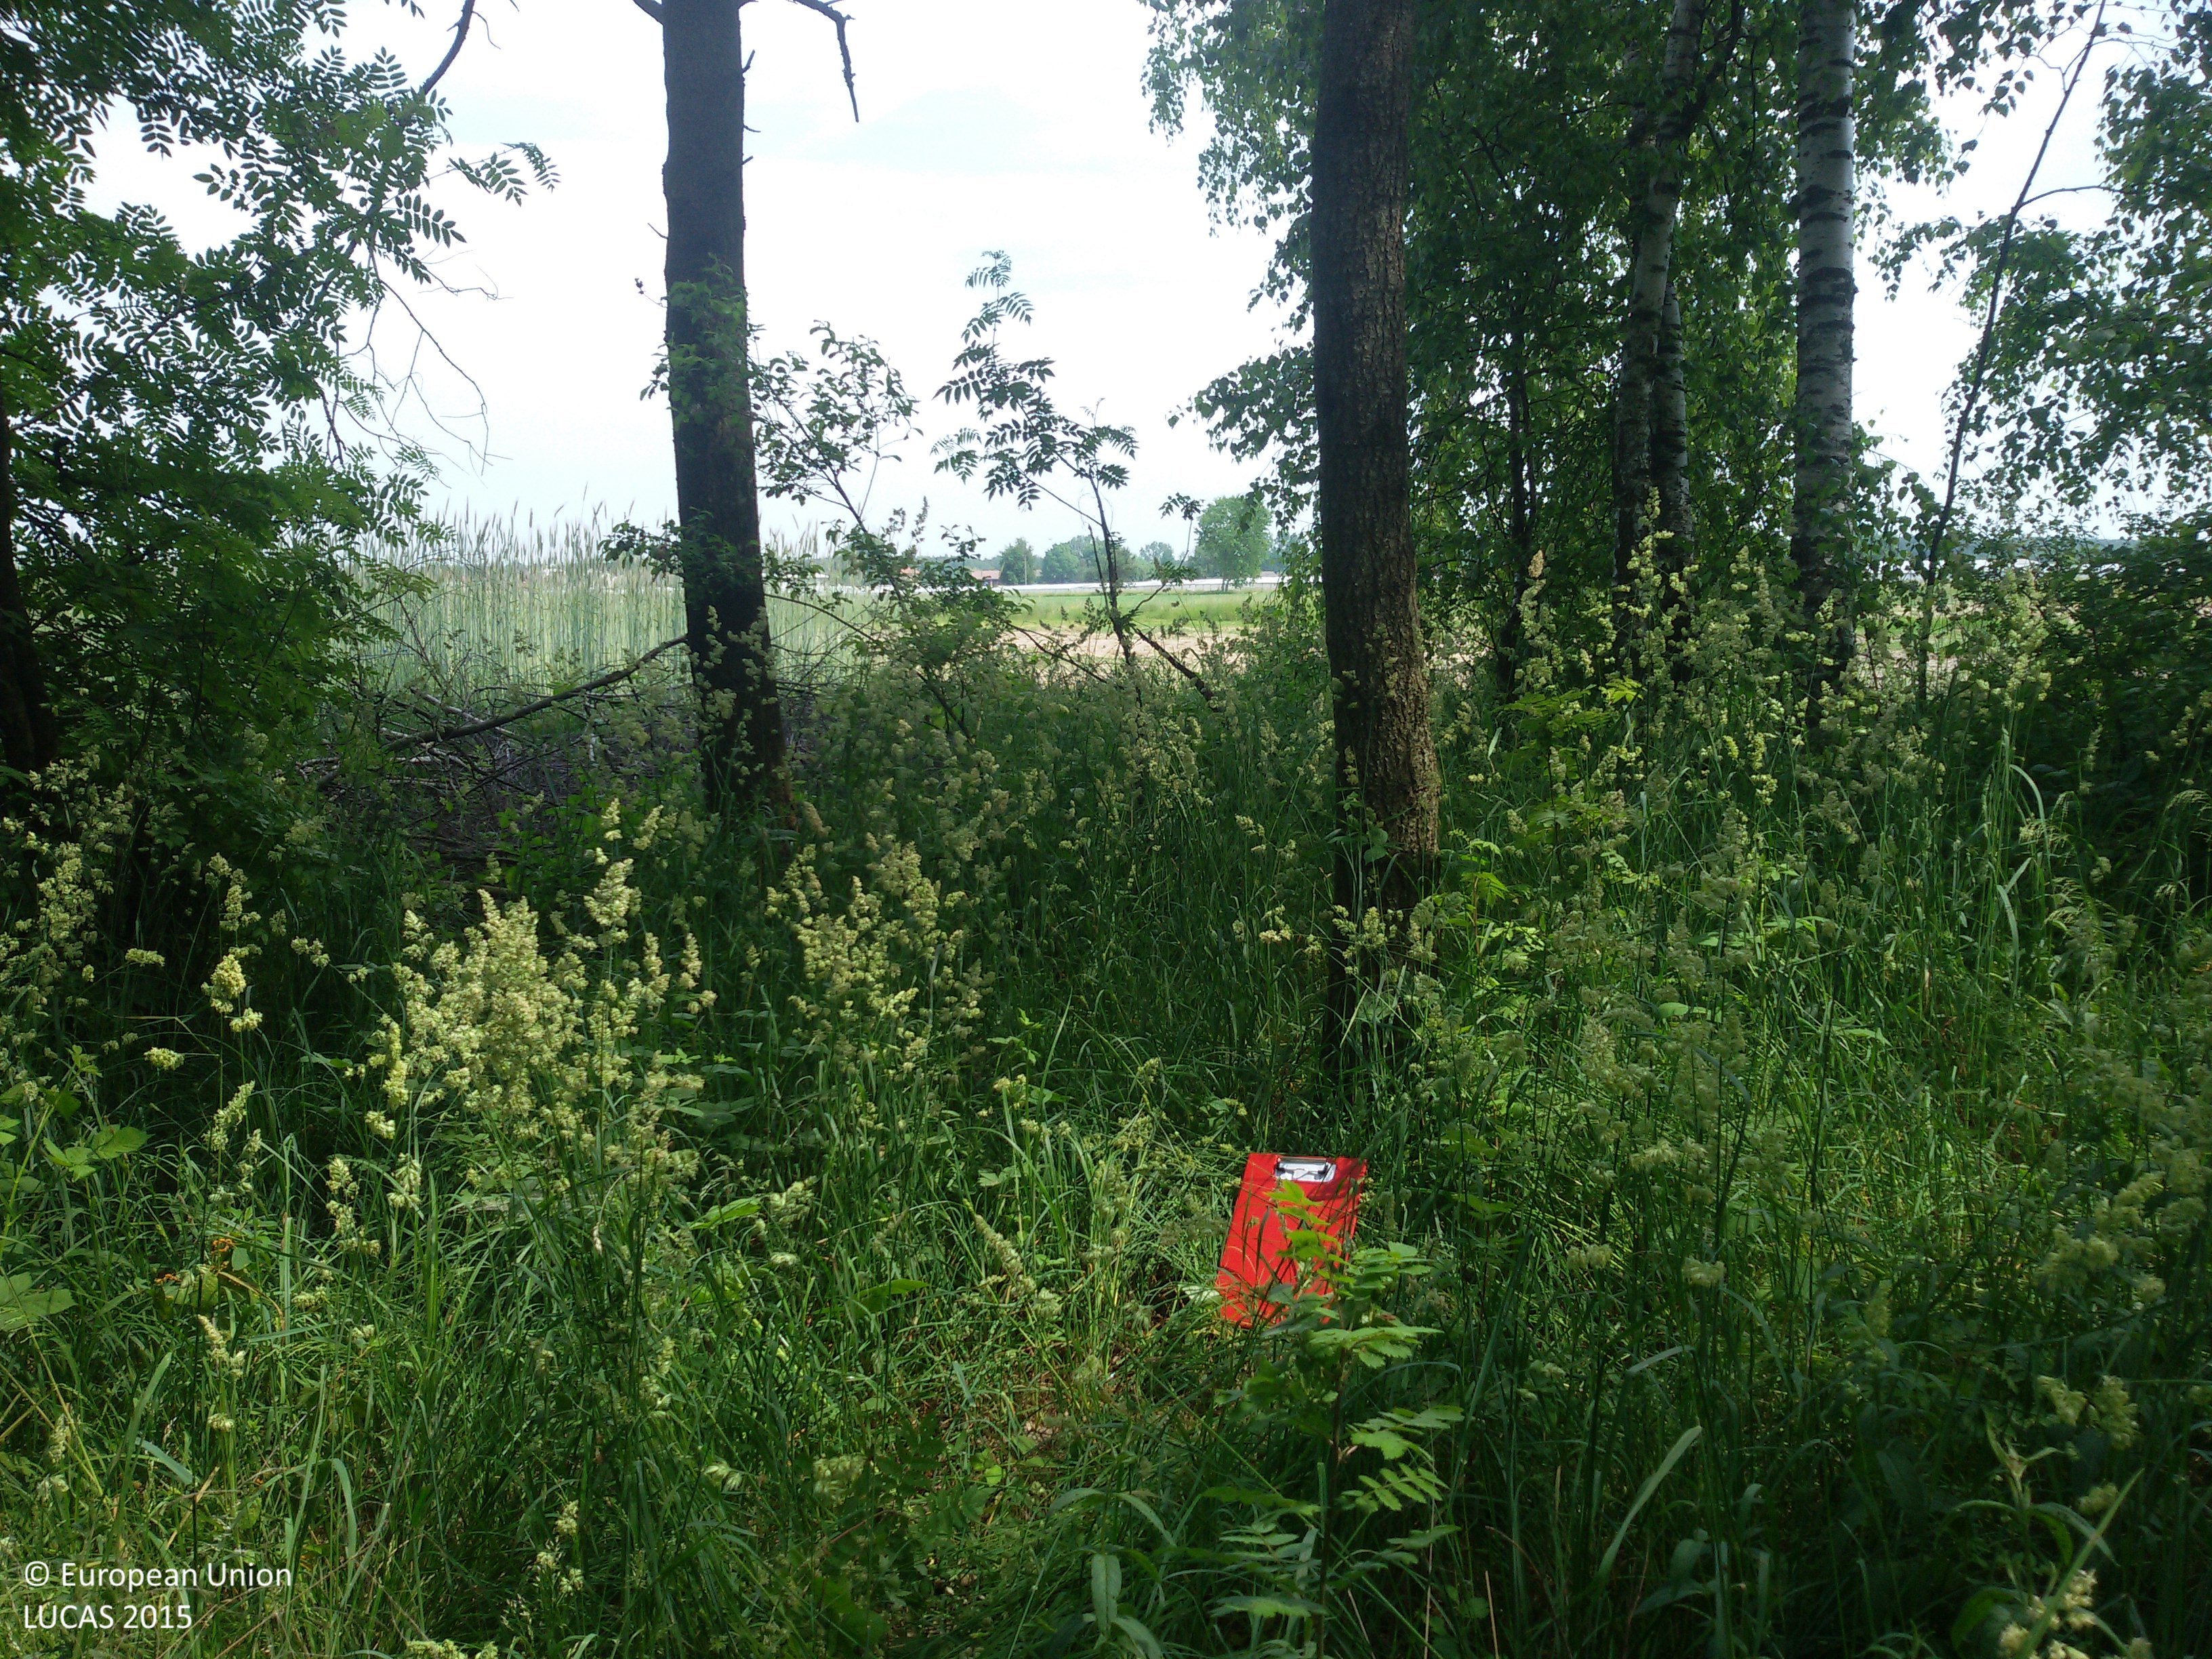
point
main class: Woodland
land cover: Broadleaved woodland
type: mesophytic deciduous forest
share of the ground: > 75 %
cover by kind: broadleaved forest trees 90 %, herbaceous plants 10 %
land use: Forestry
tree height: > 5 m
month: June
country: PL
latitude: 51.4973
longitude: 20.6564
